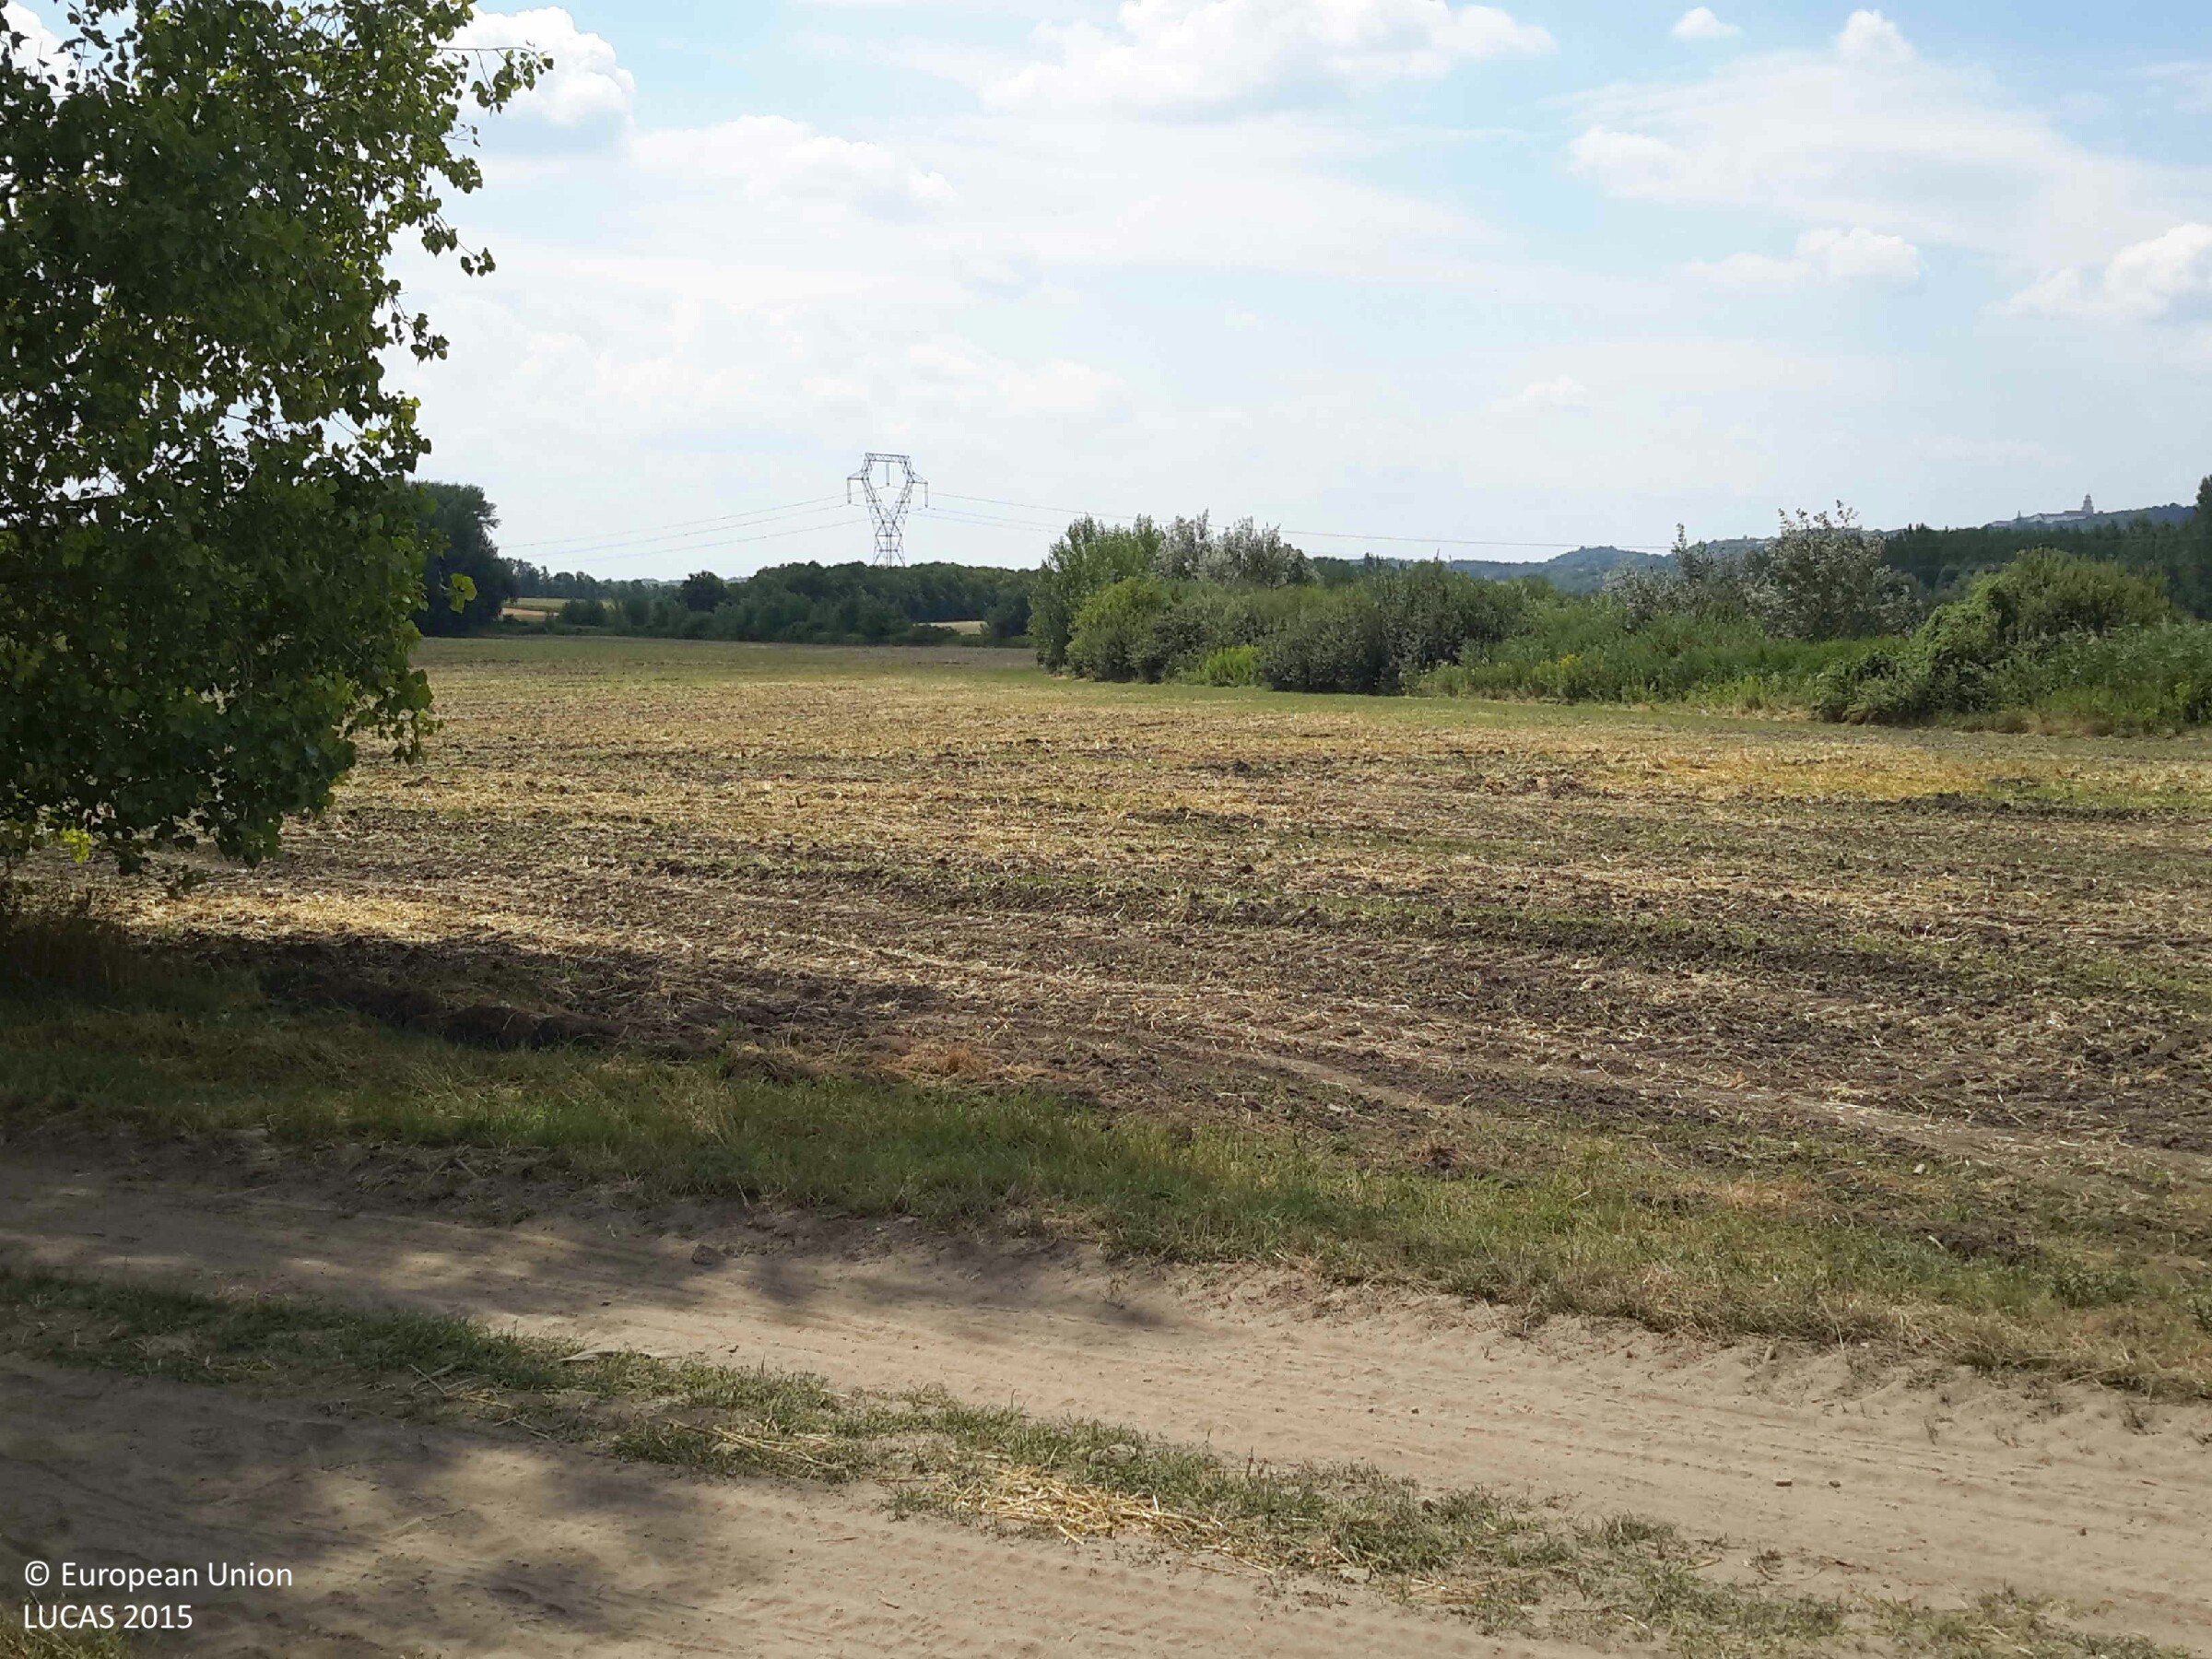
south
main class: Cropland
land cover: Common wheat
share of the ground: 50 - 75 %
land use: Agriculture (excluding fallow land and kitchen gardens)
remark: Harvested field
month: July
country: HU
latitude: 47.5862
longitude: 17.7885
